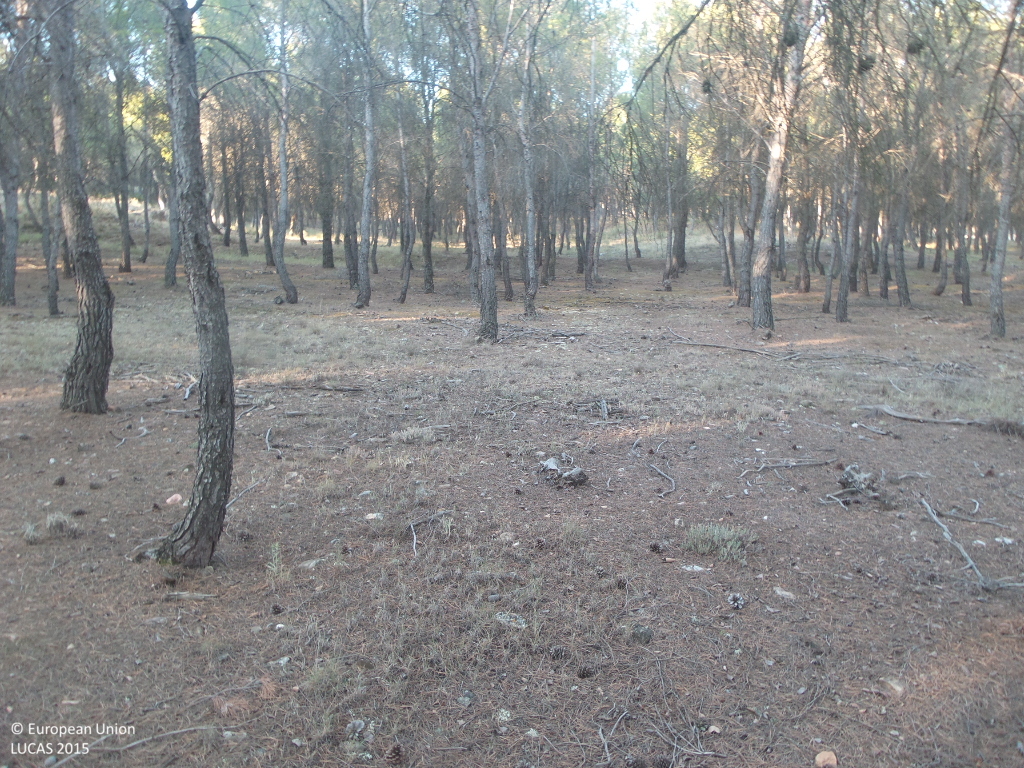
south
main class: Woodland
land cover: Pine dominated coniferous woodland
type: coniferous forest of the mediterranean region
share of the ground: > 75 %
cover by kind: coniferous forest trees 80 %, shrubs 10 %, lichens and mosses 10 %
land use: Semi-natural and natural areas not in use
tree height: > 5 m
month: July
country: ES
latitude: 41.2928
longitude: -2.0537
